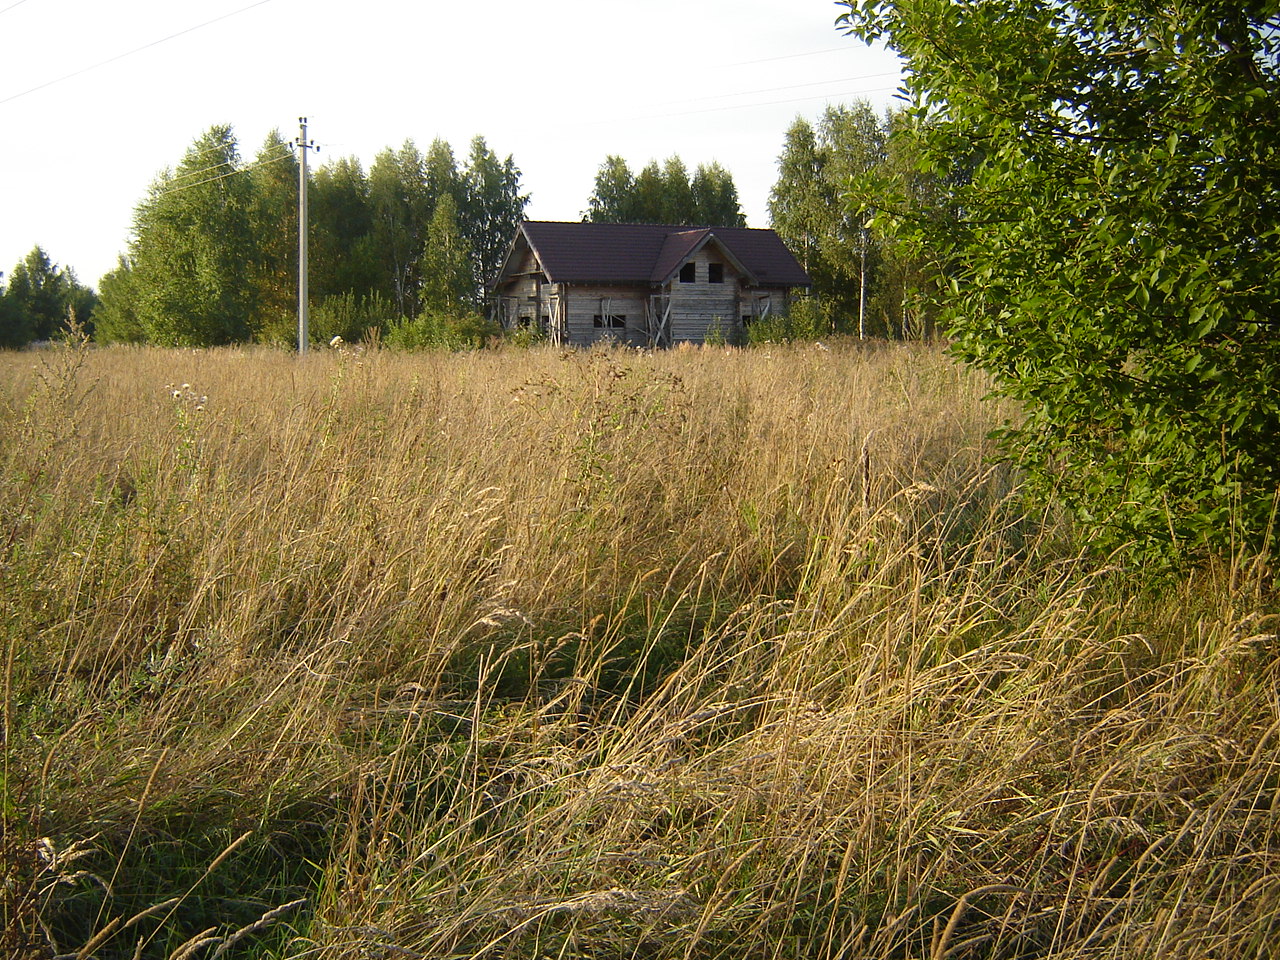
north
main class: Grassland
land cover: Grassland with sparse tree/shrub cover
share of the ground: > 75 %
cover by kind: herbaceous plants 95 %, broadleaved forest trees 5 %
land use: Fallow land
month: August
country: LT
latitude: 54.5812
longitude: 25.1732
